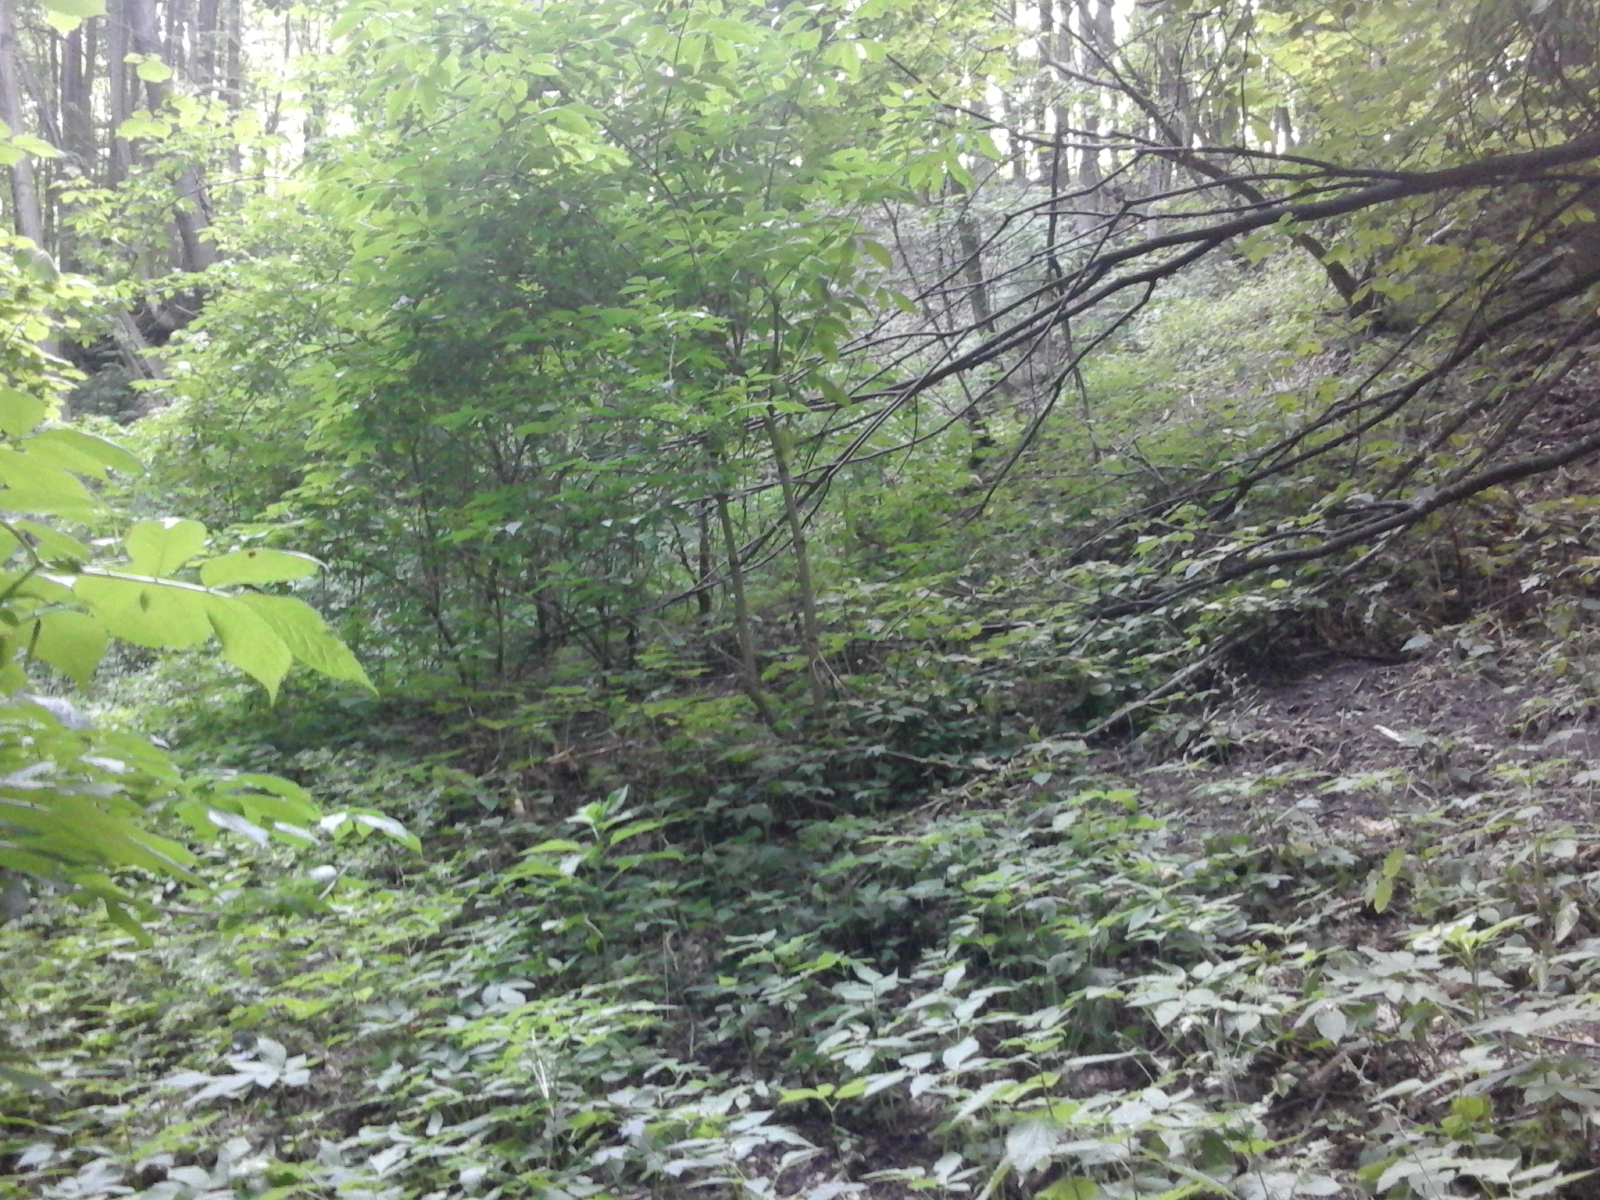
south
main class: Woodland
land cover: Broadleaved woodland
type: mesophytic deciduous forest
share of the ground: > 75 %
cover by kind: broadleaved forest trees 100 %
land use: Forestry
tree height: > 5 m
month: June
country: RO
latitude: 46.9959
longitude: 27.5940
